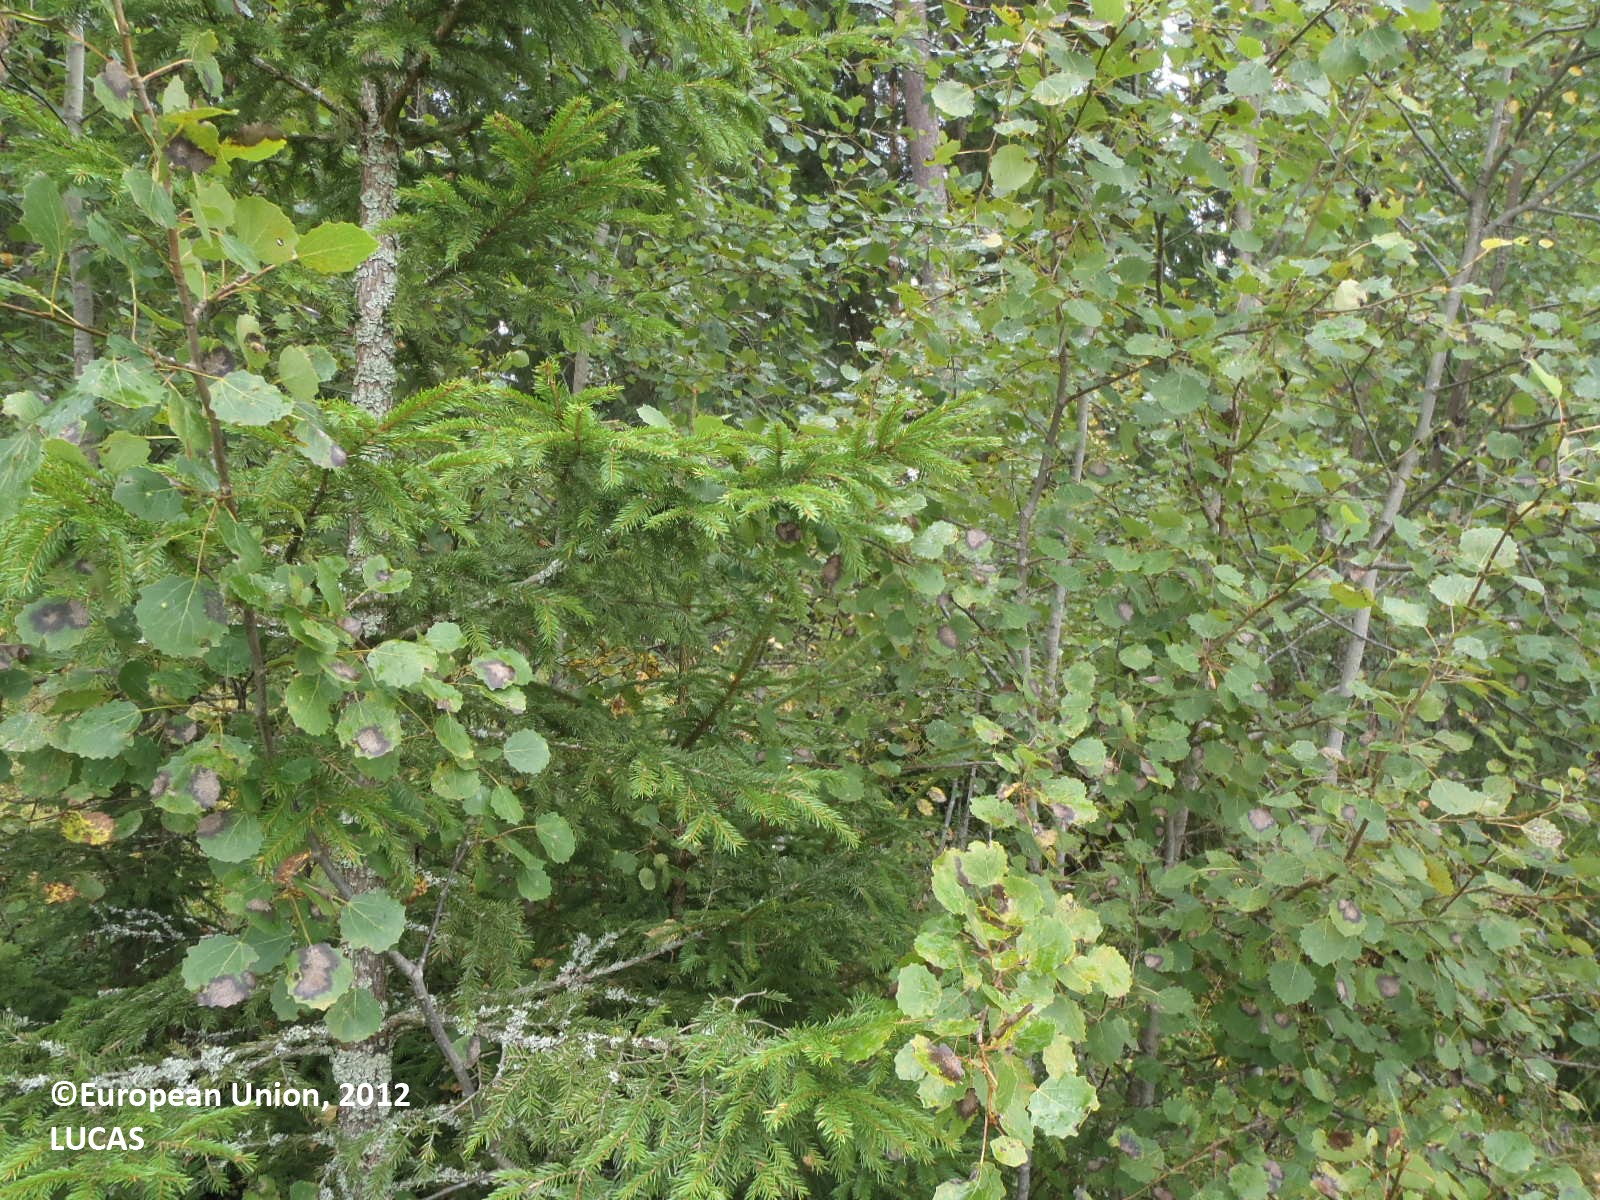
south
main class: Cropland
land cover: Barley
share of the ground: > 75 %
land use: Agriculture (excluding fallow land and kitchen gardens)
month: August
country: FI
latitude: 60.5555
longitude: 22.2668
